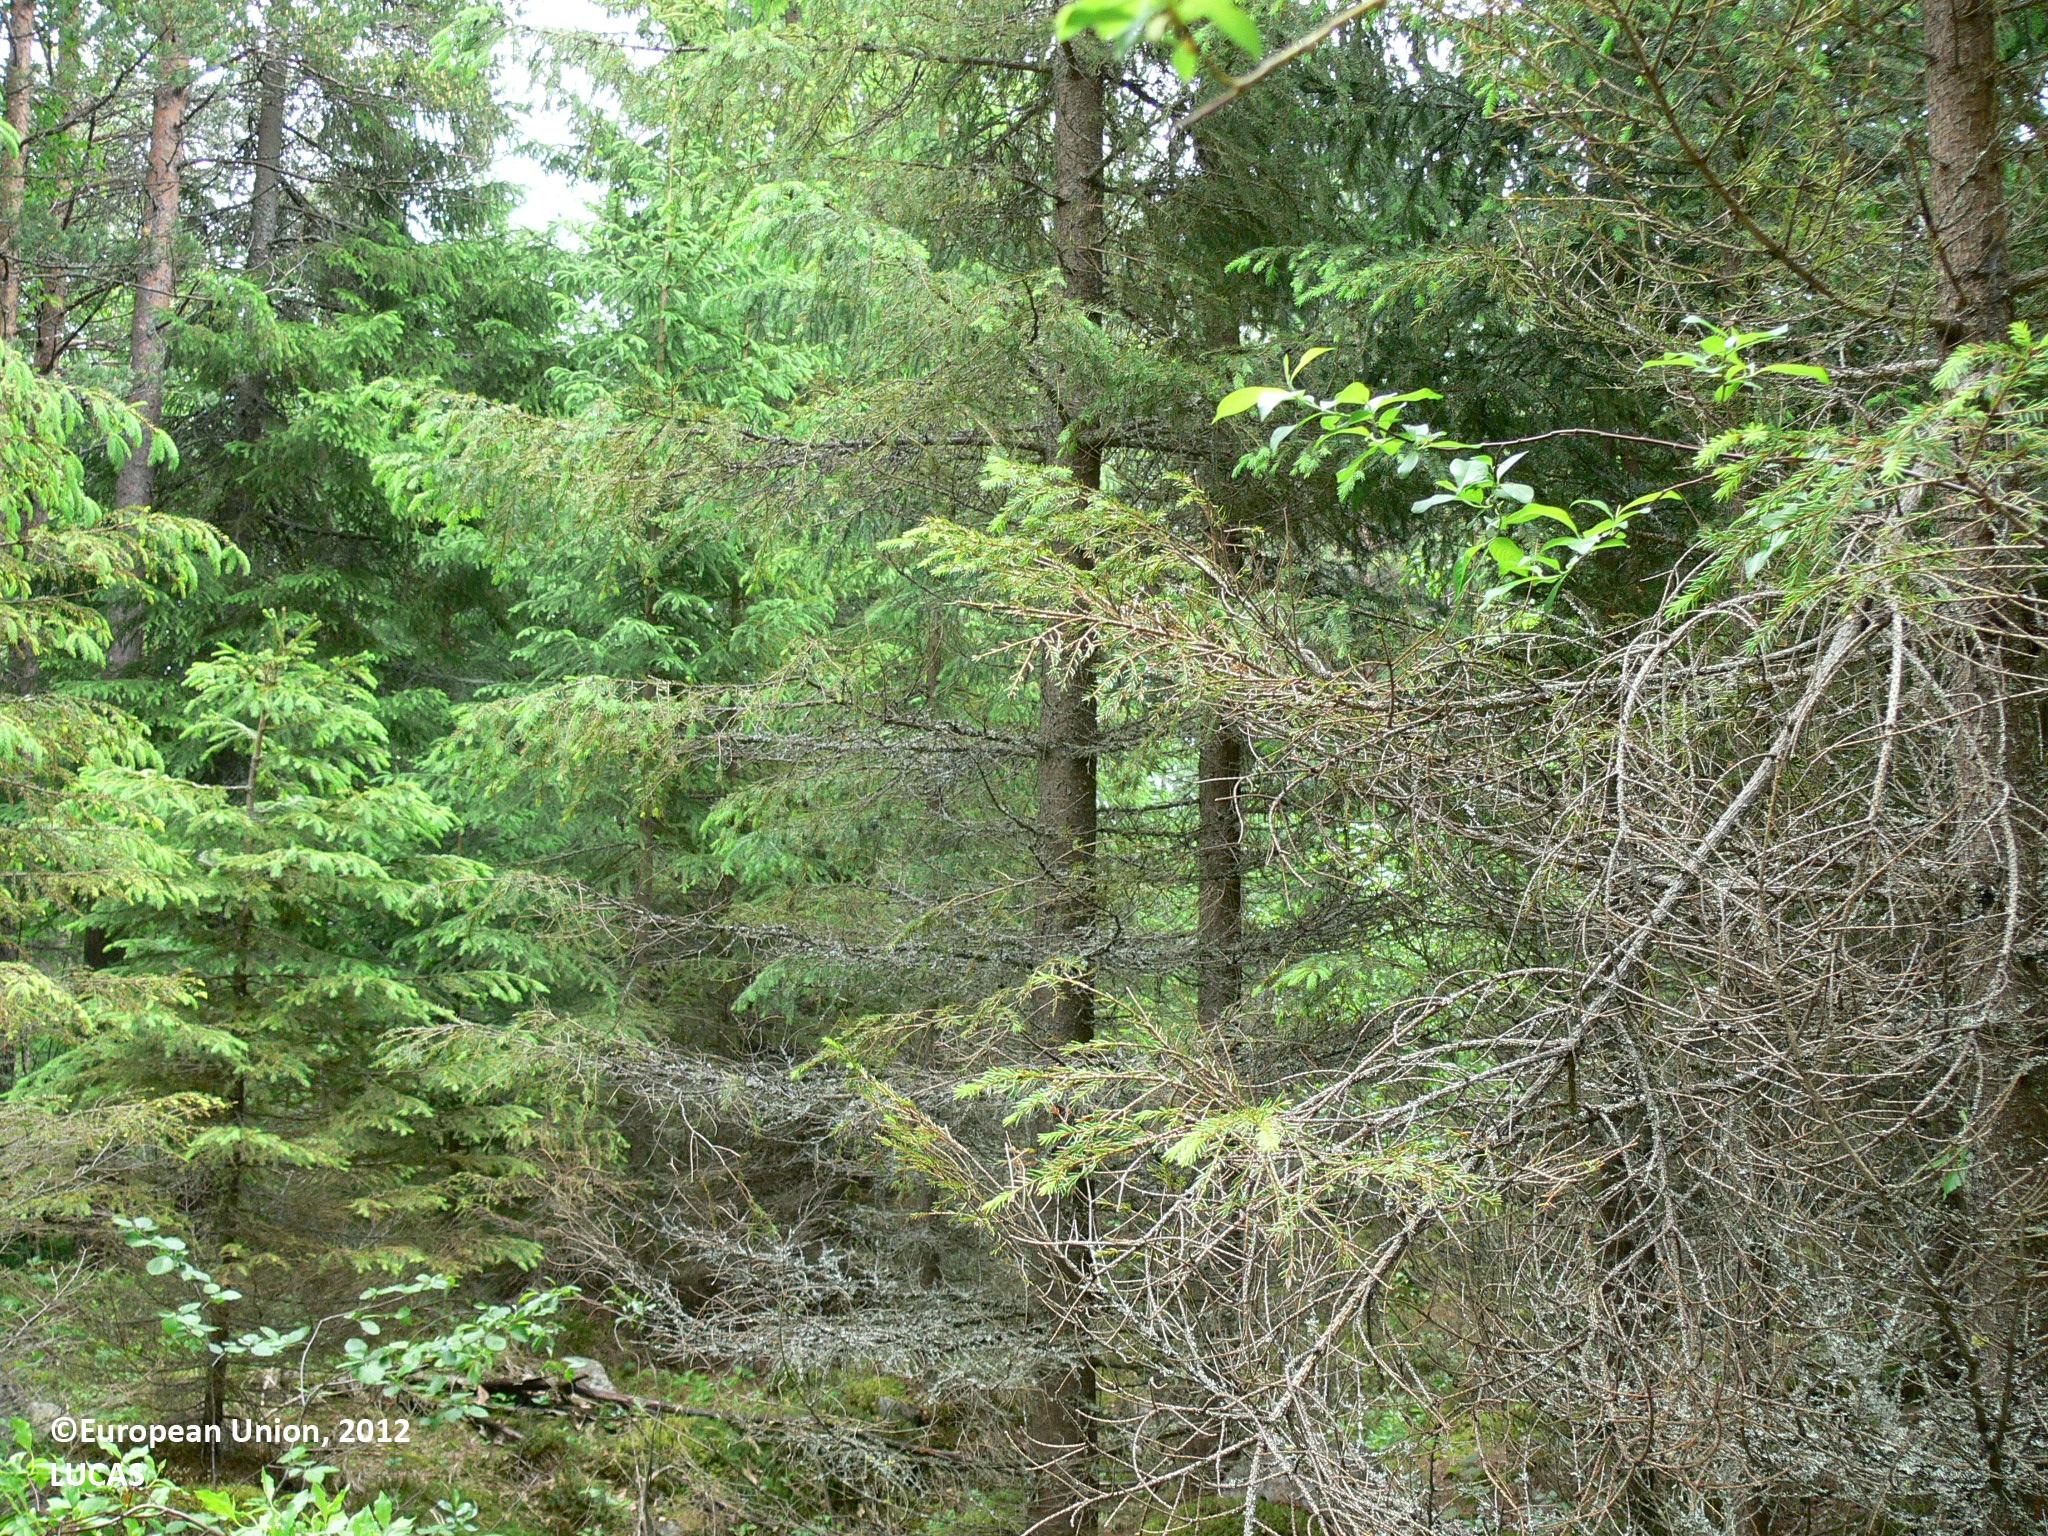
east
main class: Woodland
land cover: Spruce dominated coniferous woodland
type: boreal forest
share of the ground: > 75 %
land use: Forestry
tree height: > 5 m
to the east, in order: Spruce dominated coniferous woodland; Spruce dominated mixed woodland; Spruce dominated coniferous woodland; Other coniferous woodland; Pine dominated coniferous woodland; Other coniferous woodland
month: June
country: FI
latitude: 62.7682
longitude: 30.5149
